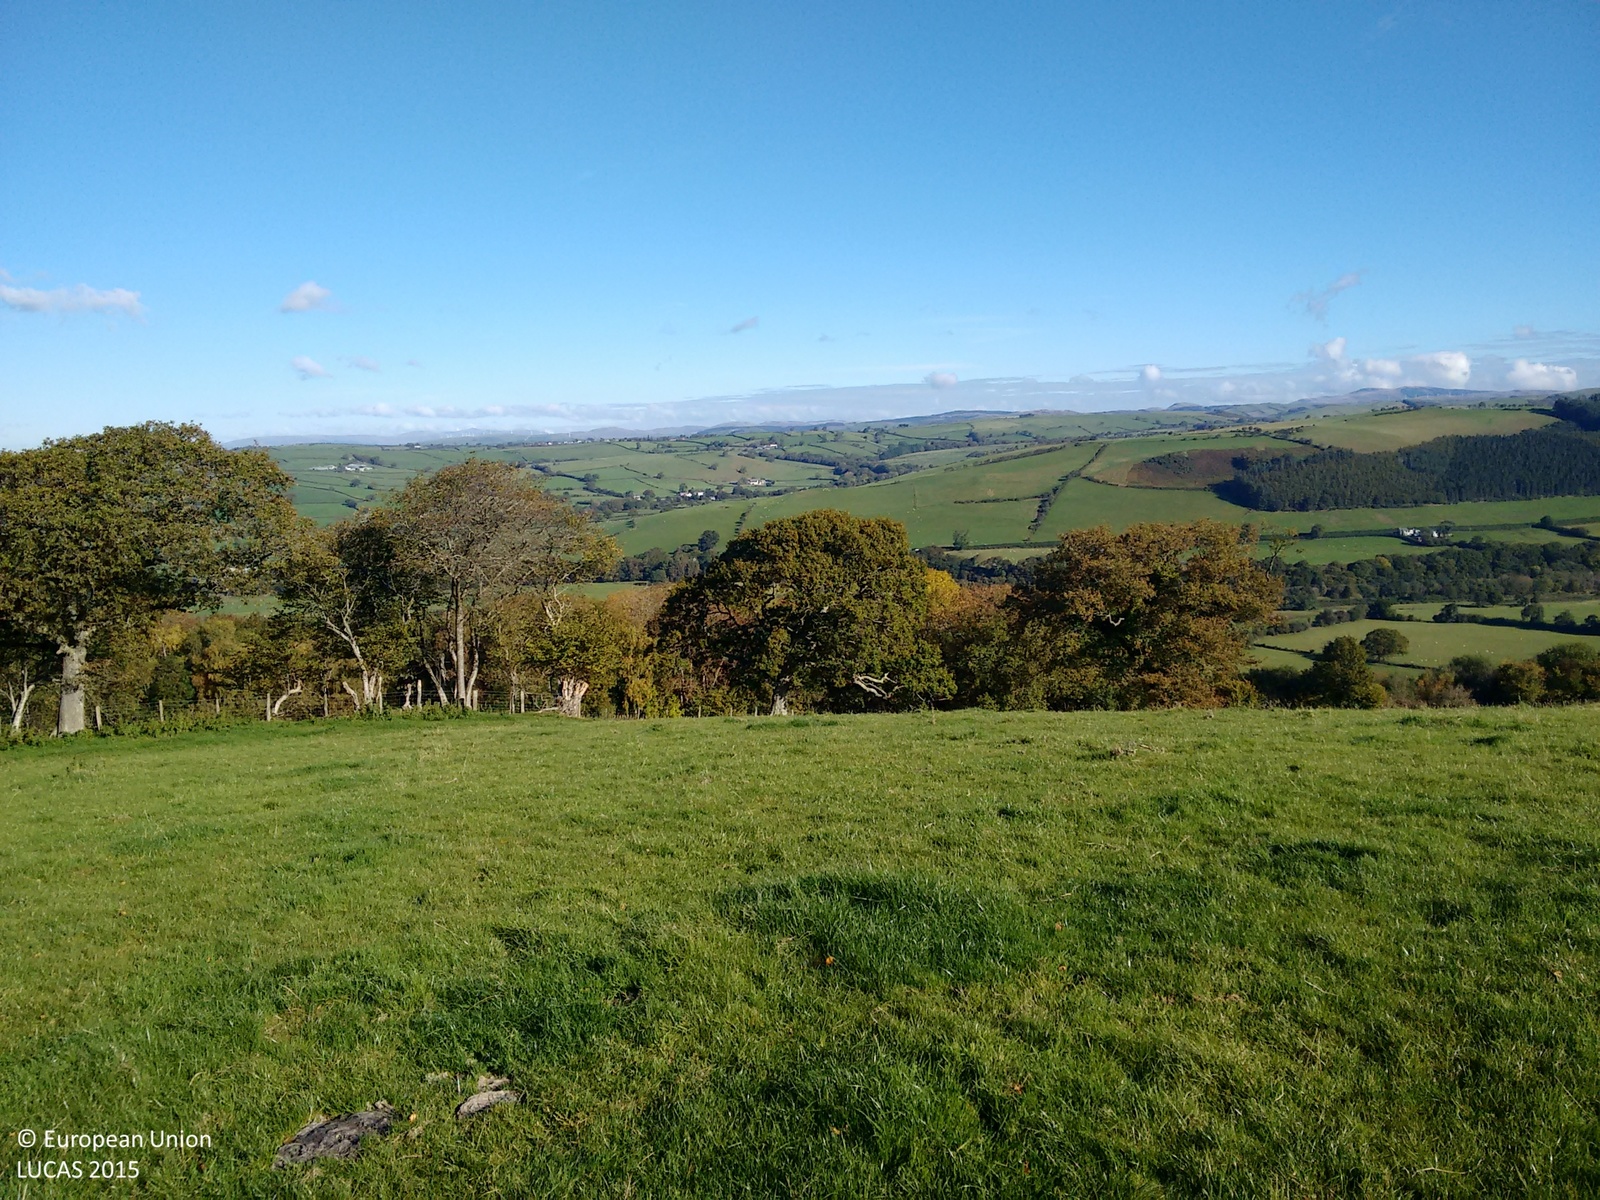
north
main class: Grassland
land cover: Grassland without tree/shrub cover
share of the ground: > 75 %
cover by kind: herbaceous plants 100 %
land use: Agriculture (excluding fallow land and kitchen gardens)
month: October
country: GB
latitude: 52.3462
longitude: -3.9960
